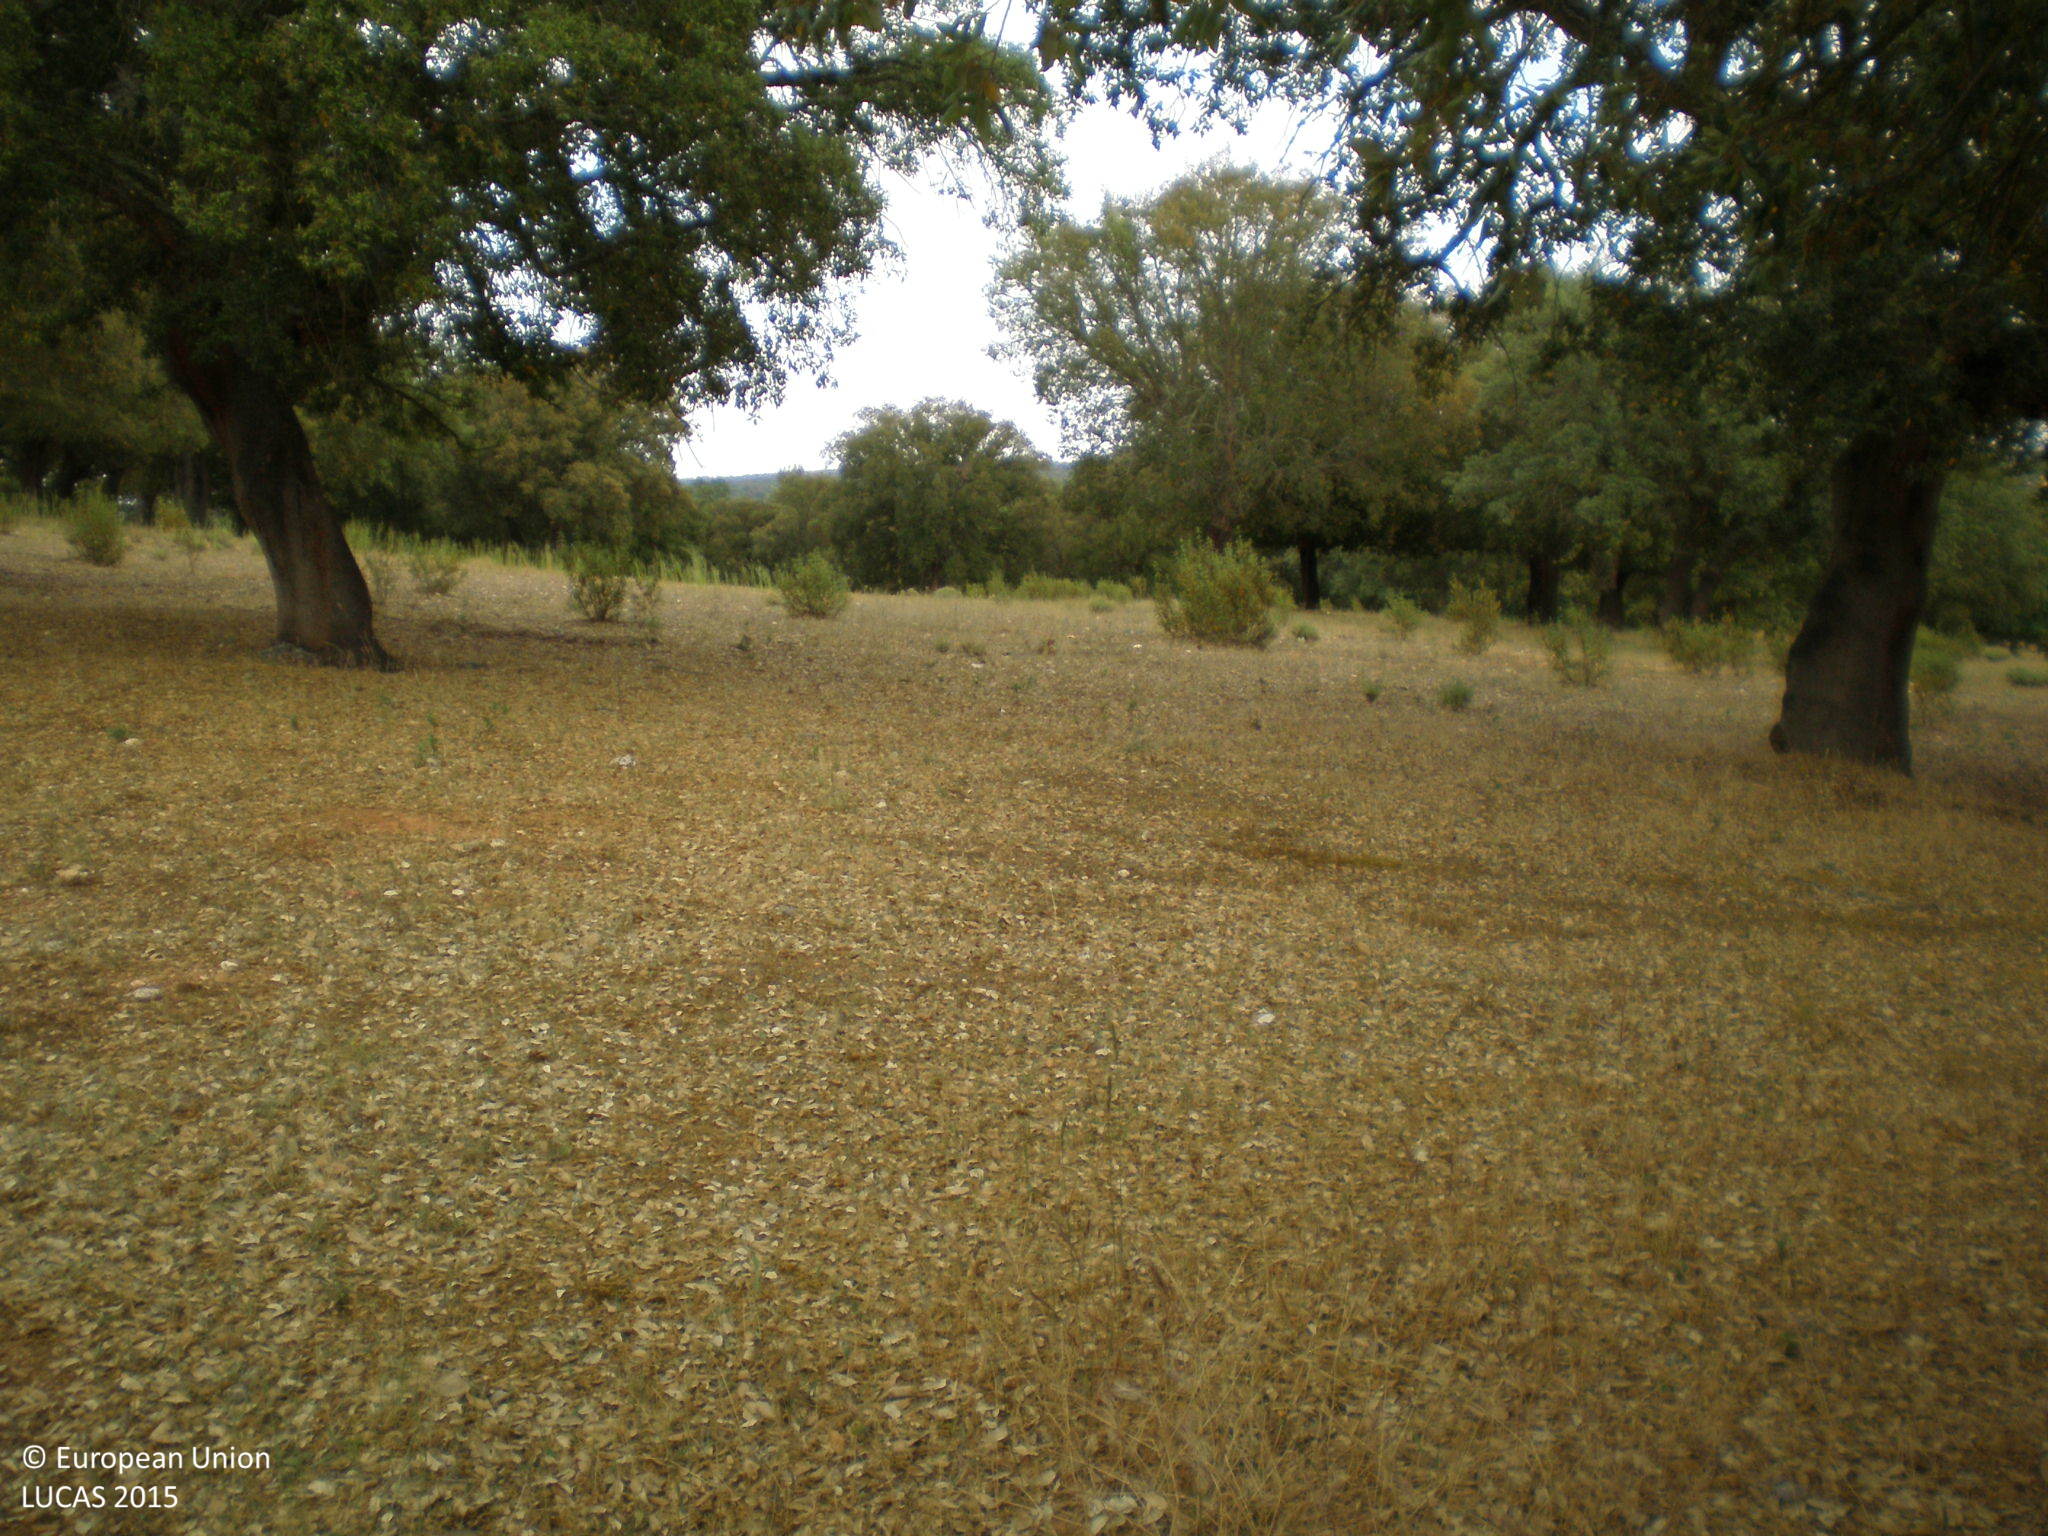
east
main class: Woodland
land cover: Broadleaved woodland
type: broadleaved evergreen forest
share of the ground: 25 - 50 %
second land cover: Grassland without tree/shrub cover
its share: 50 - 75 %
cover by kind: herbaceous plants 55 %, broadleaved forest trees 45 %
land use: Forestry
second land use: Agriculture (excluding fallow land and kitchen gardens)
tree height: > 5 m
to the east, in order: Broadleaved woodland; Grassland without tree/shrub cover
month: June
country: ES
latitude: 41.1868
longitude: -5.7844
